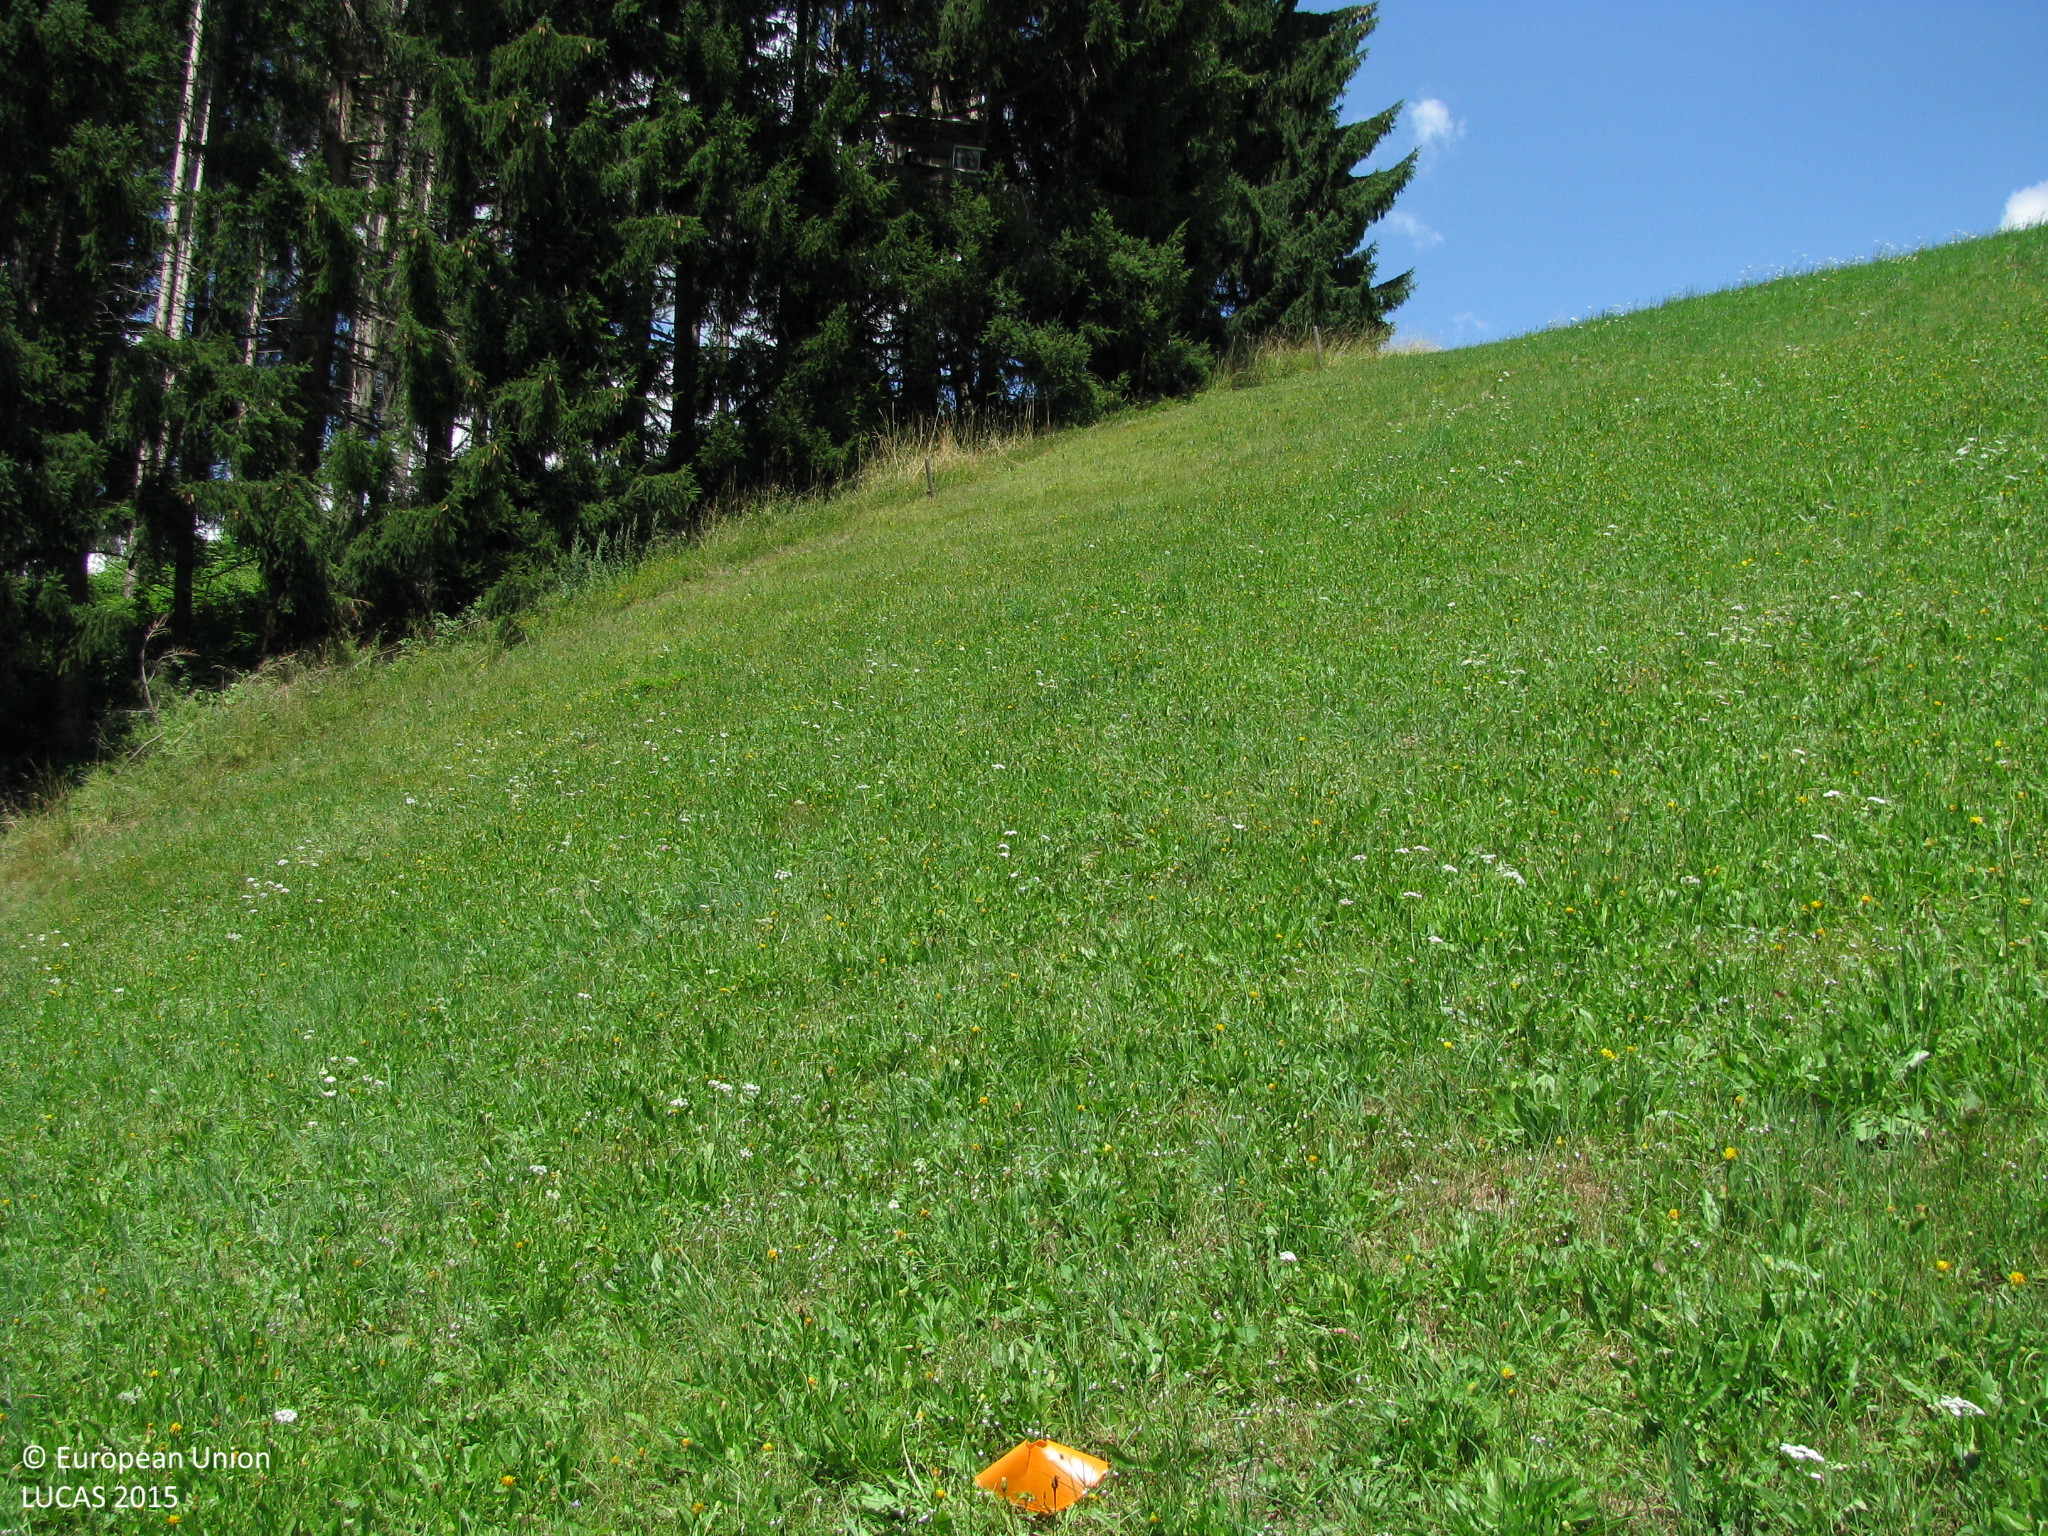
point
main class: Grassland
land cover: Grassland without tree/shrub cover
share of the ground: > 75 %
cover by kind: herbaceous plants 100 %
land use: Agriculture (excluding fallow land and kitchen gardens)
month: July
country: AT
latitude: 46.7371
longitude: 12.4711
